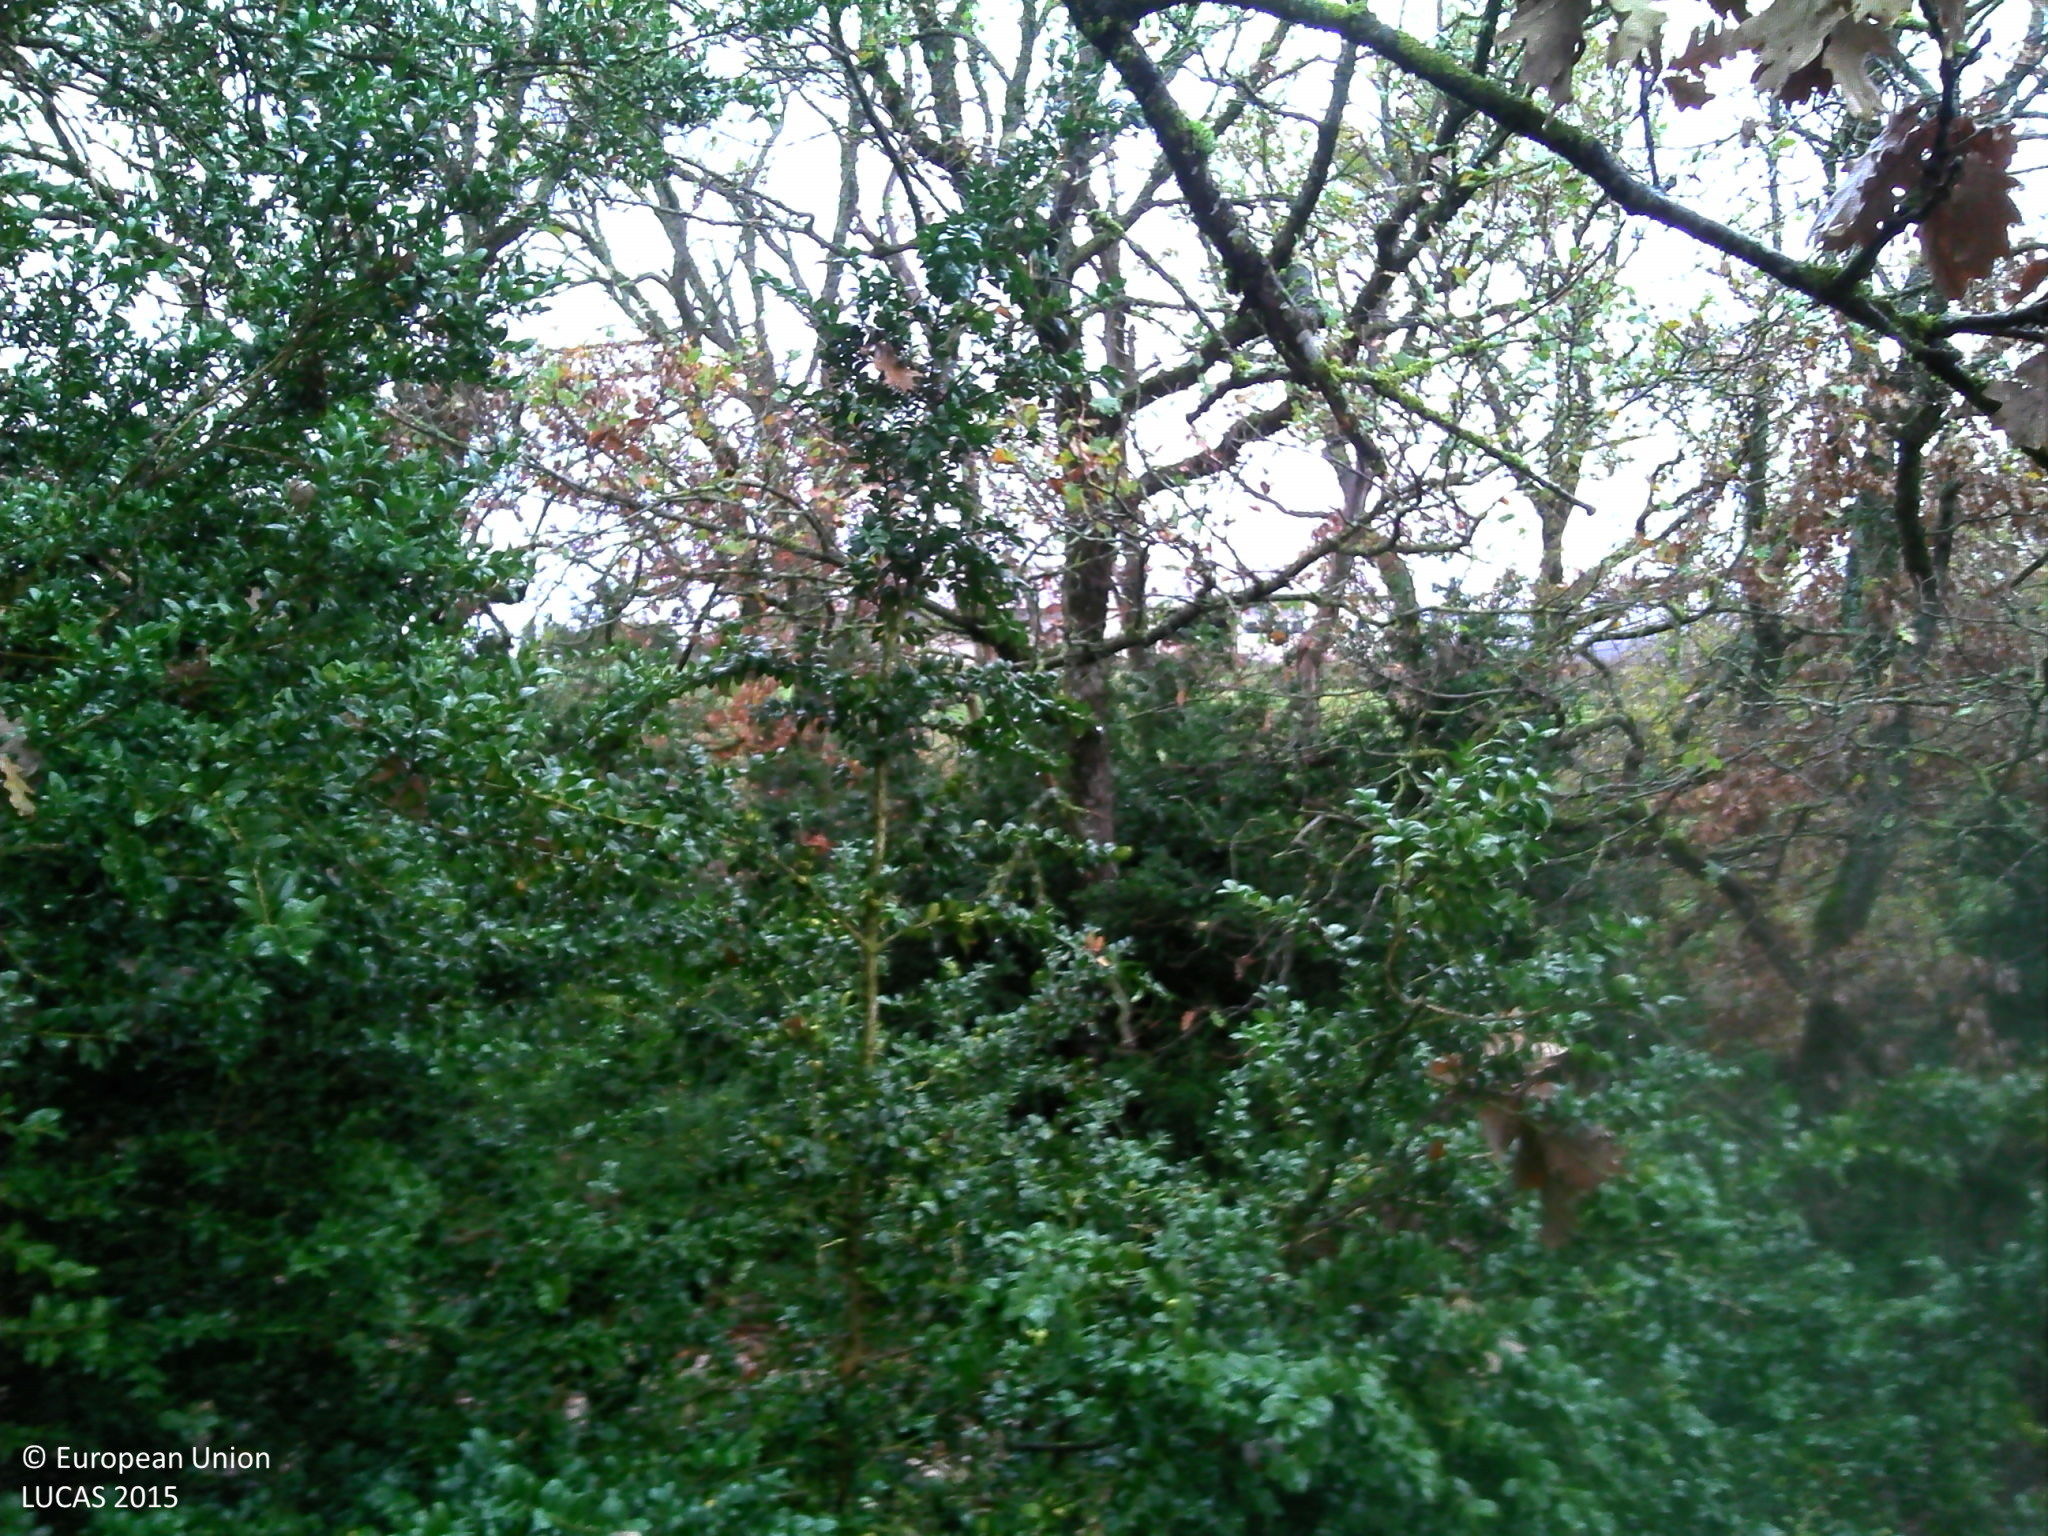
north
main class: Woodland
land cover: Broadleaved woodland
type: mesophytic deciduous forest
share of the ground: > 75 %
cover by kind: broadleaved forest trees 100 %
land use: Forestry
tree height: > 5 m
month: November
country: FR
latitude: 44.0061
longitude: 3.0092
